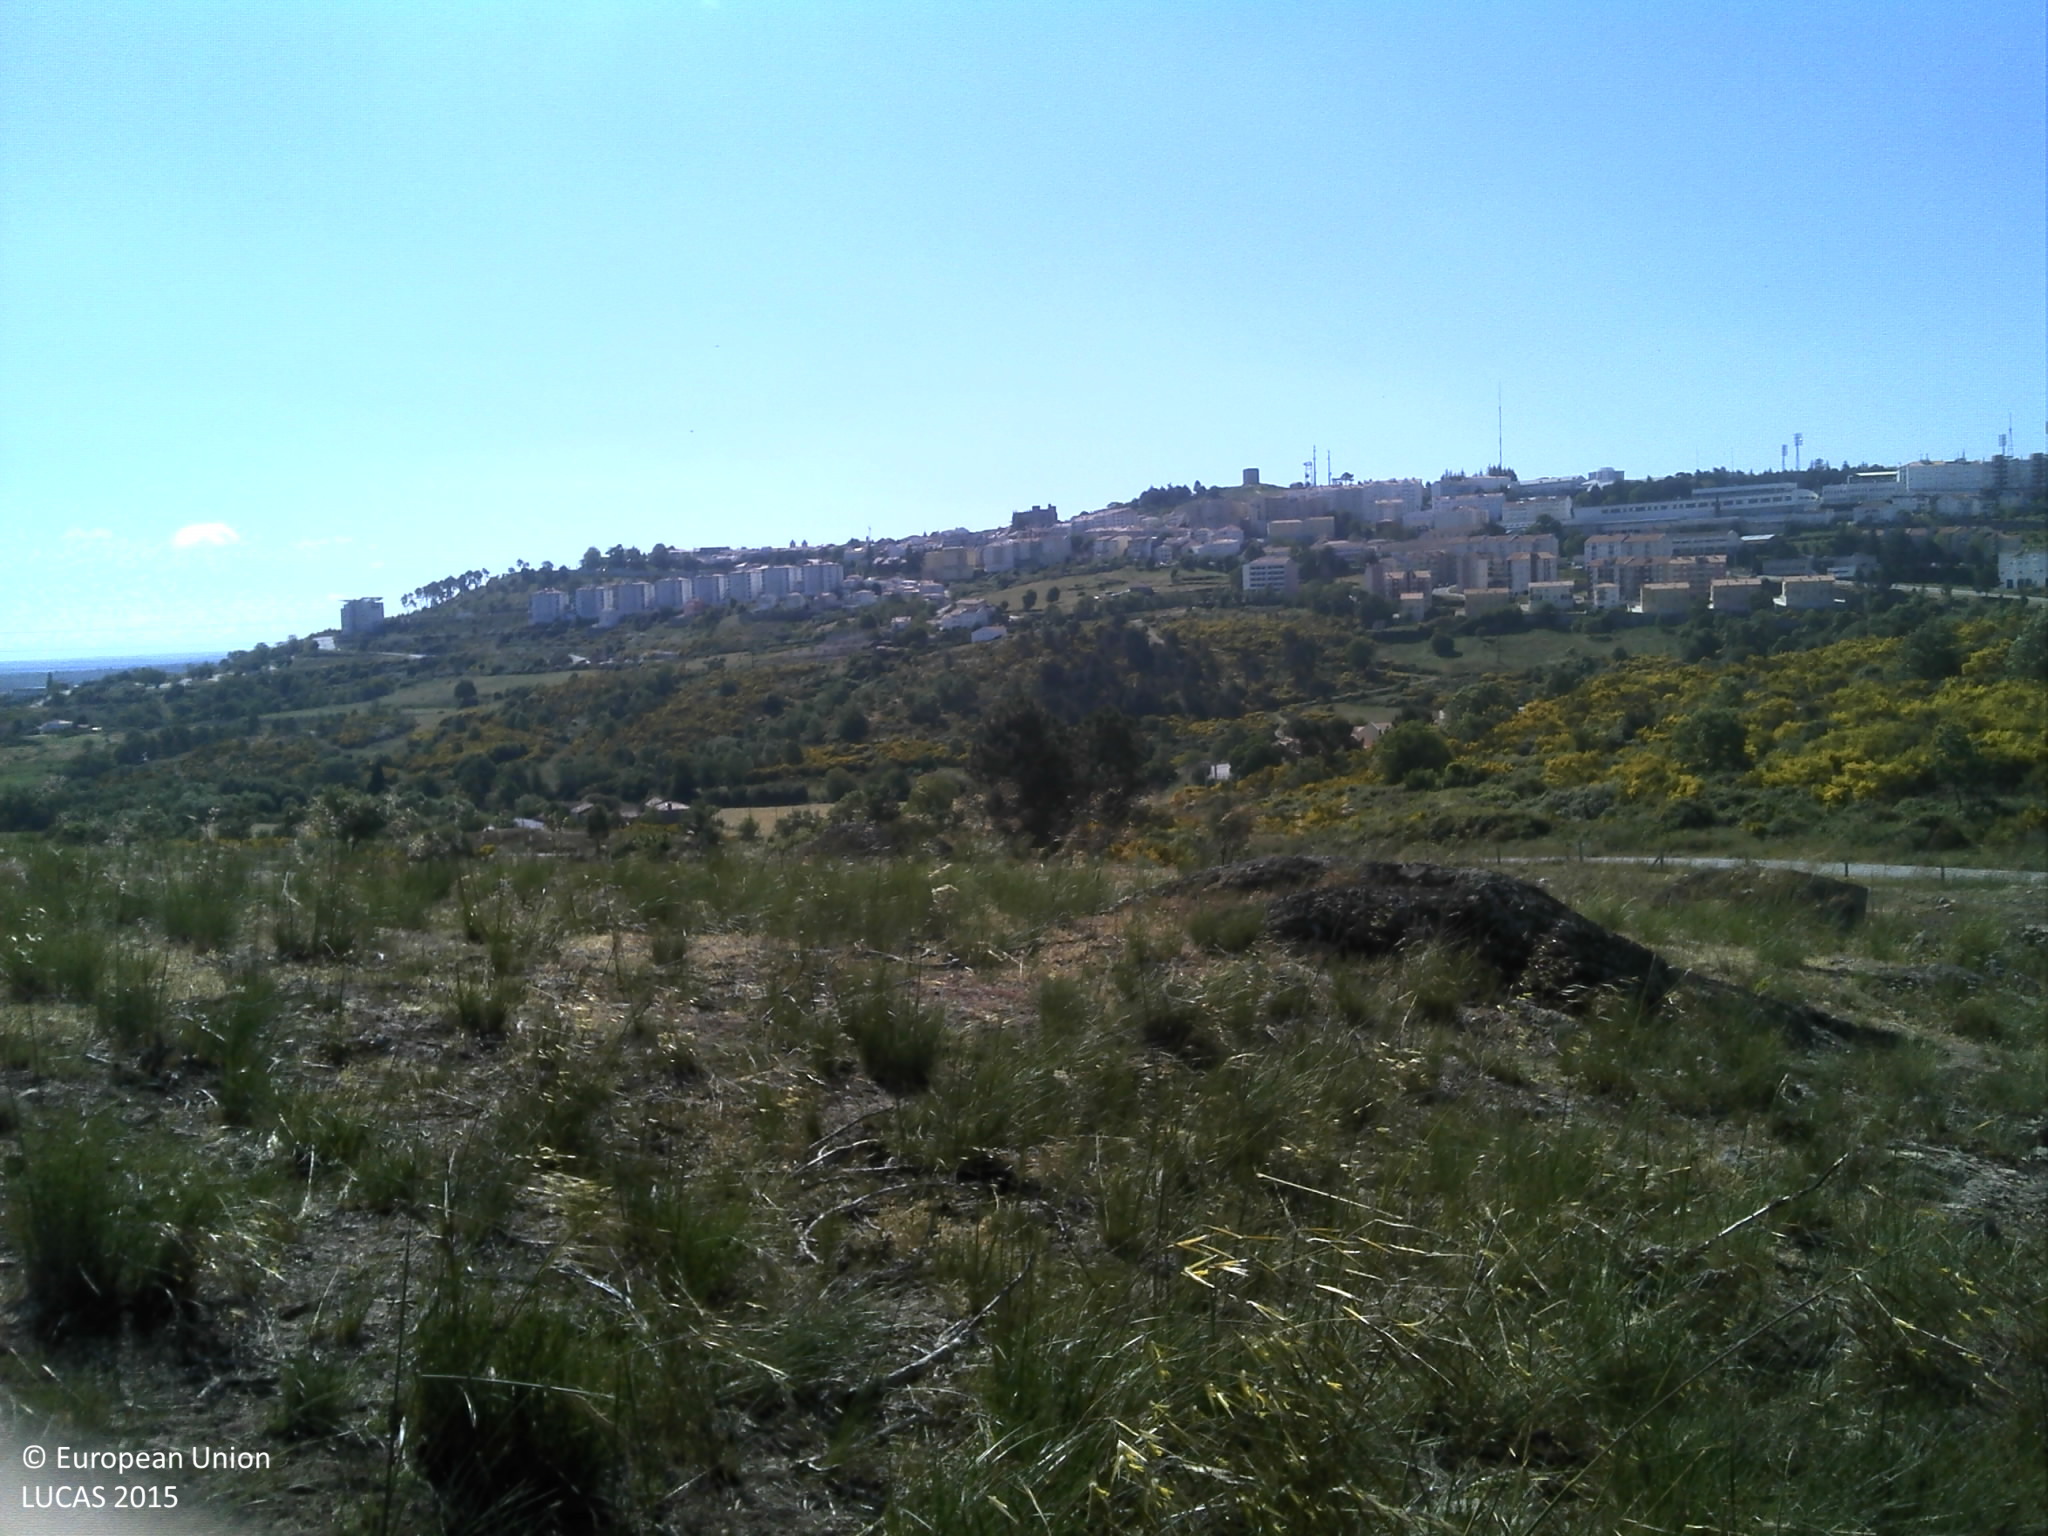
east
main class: Grassland
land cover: Grassland without tree/shrub cover
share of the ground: 10 - 25 %
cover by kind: unconsolidated bare surface 65 %, herbaceous plants 25 %, shrubs 5 %
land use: Agriculture (excluding fallow land and kitchen gardens)
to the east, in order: Grassland without tree/shrub cover; Electric lines; Grassland without tree/shrub cover; Electric lines; Grassland without tree/shrub cover; Rocks and stones; Grassland without tree/shrub cover; Shrubland without tree cover
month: May
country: PT
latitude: 40.5459
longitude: -7.2869
